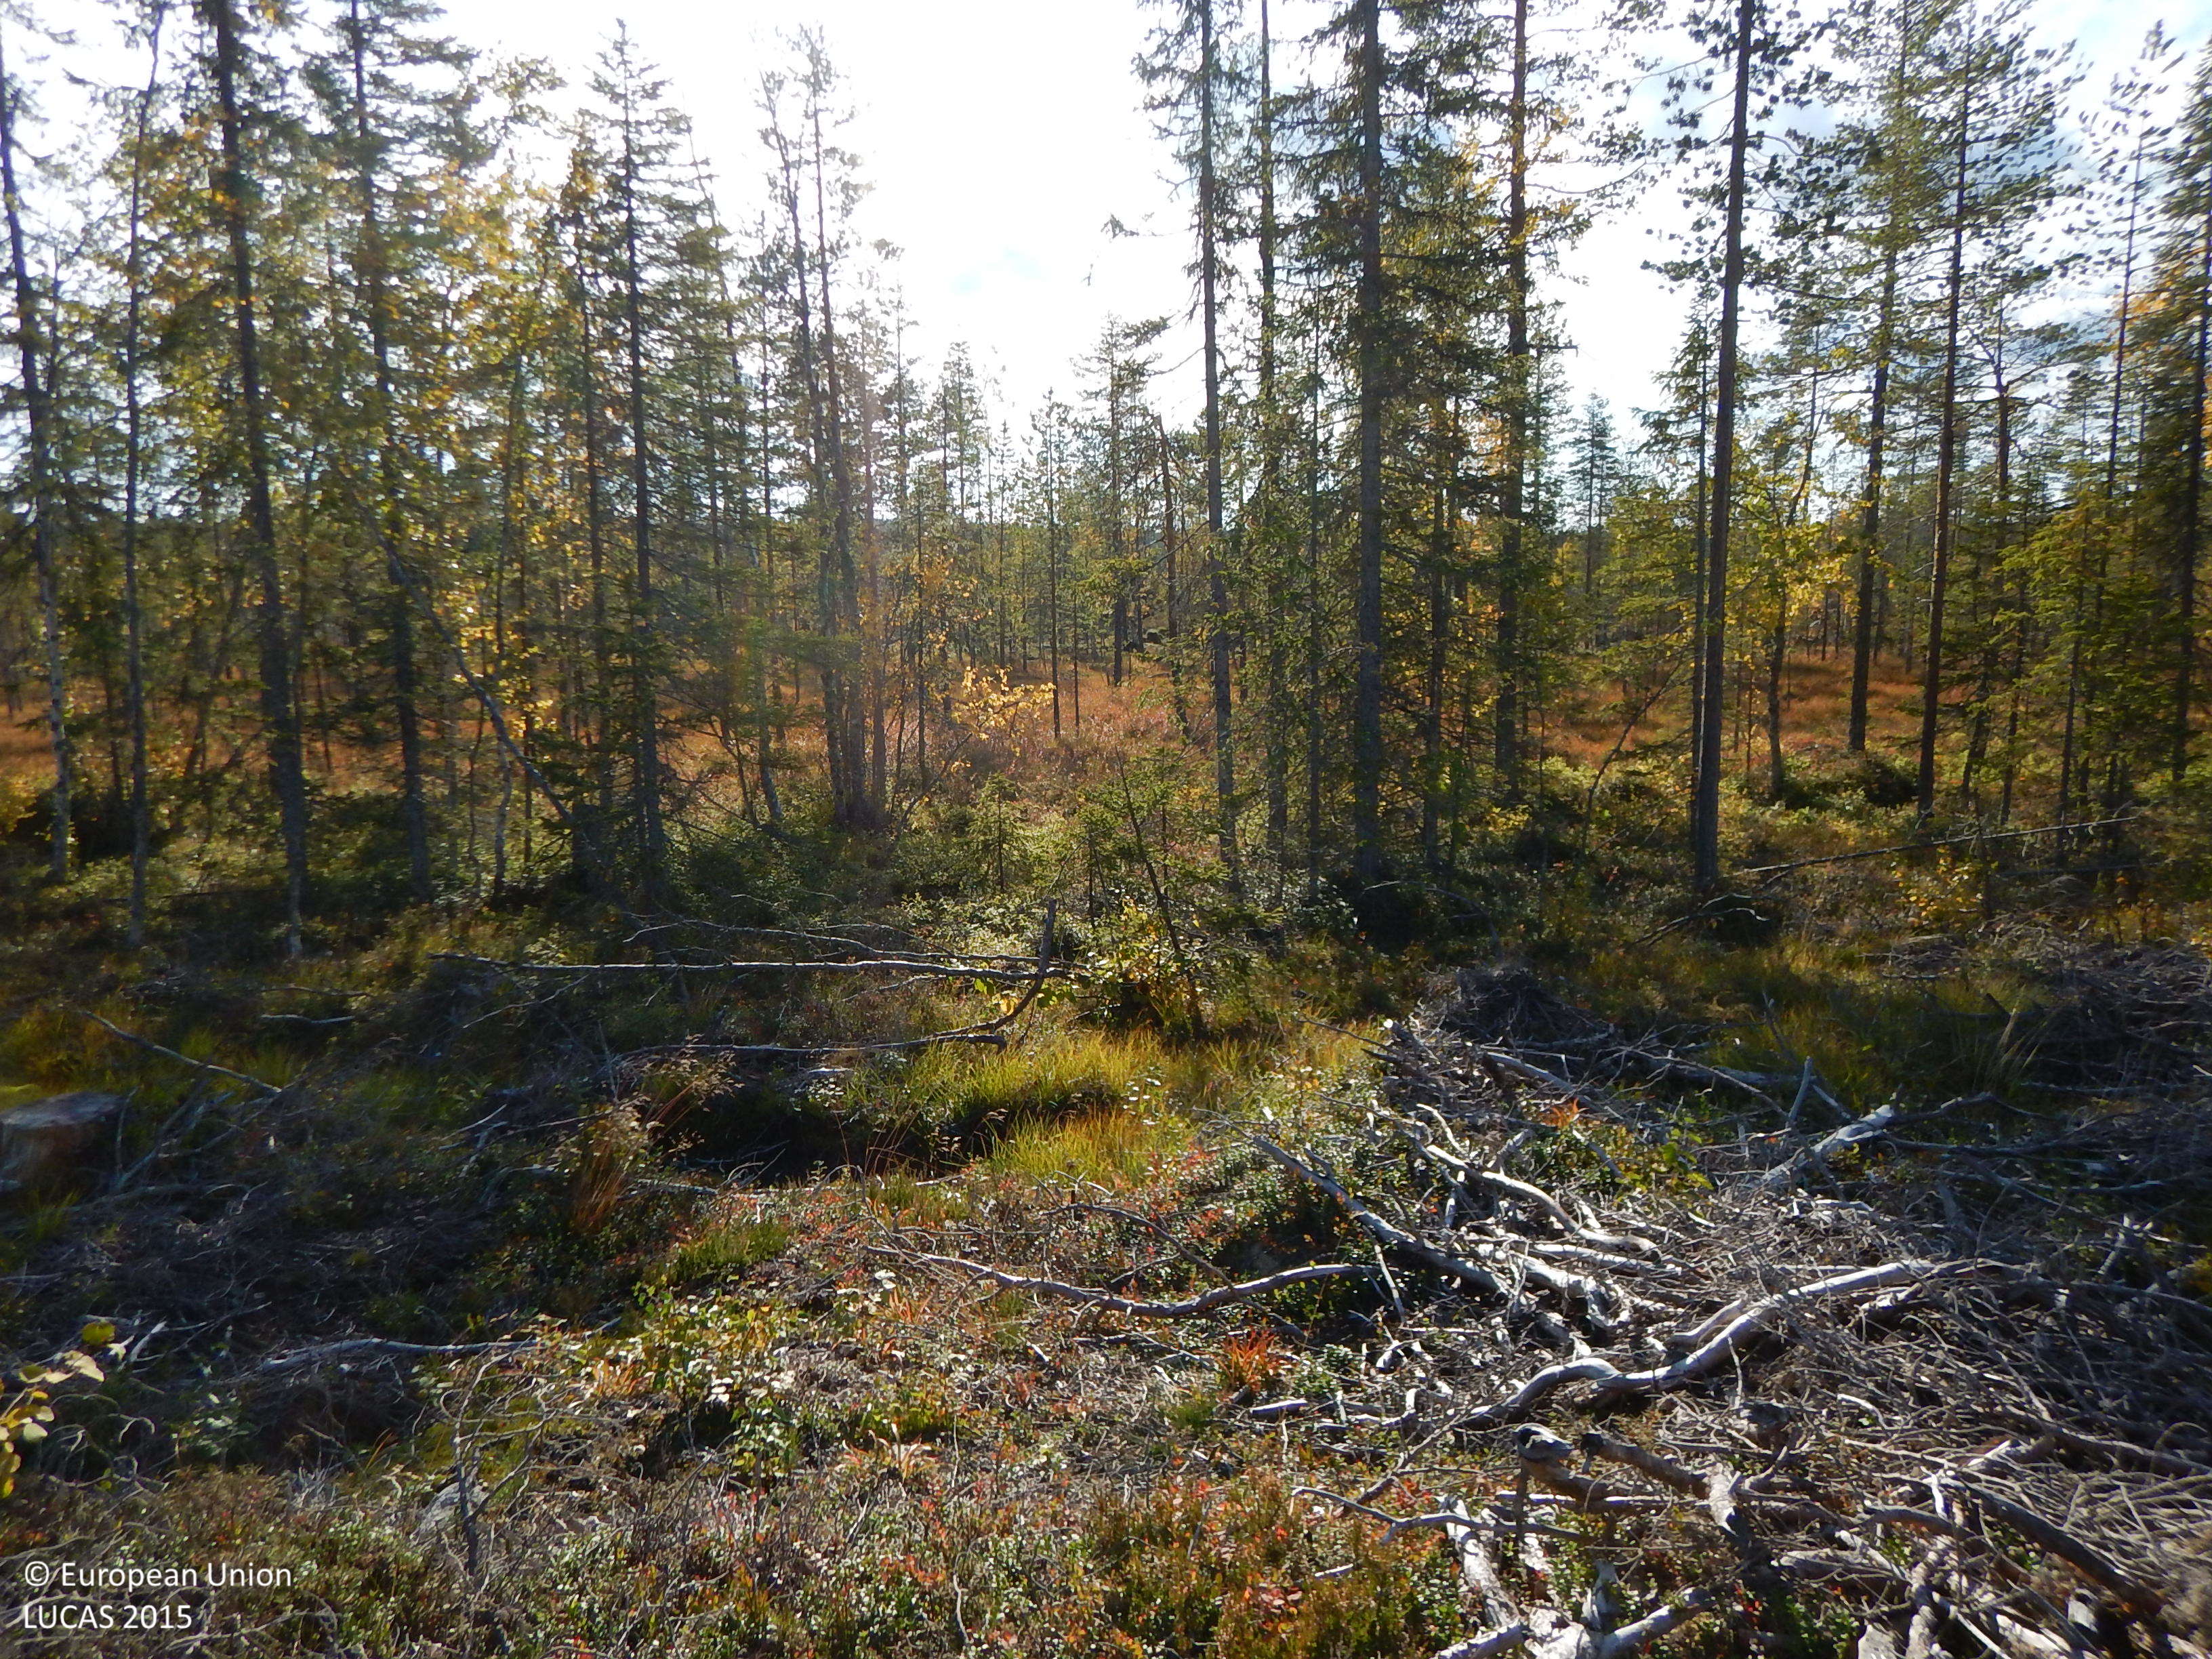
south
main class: Shrubland
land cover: Shrubland with sparse tree cover
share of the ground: 50 - 75 %
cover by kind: shrubs 45 %, unconsolidated bare surface 20 %, herbaceous plants 15 %, lichens and mosses 10 %, coniferous forest trees 5 %, consolidated bare surface 5 %
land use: Forestry
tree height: < 5 m
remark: Clear cut
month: September
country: SE
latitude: 64.7820
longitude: 20.1746
